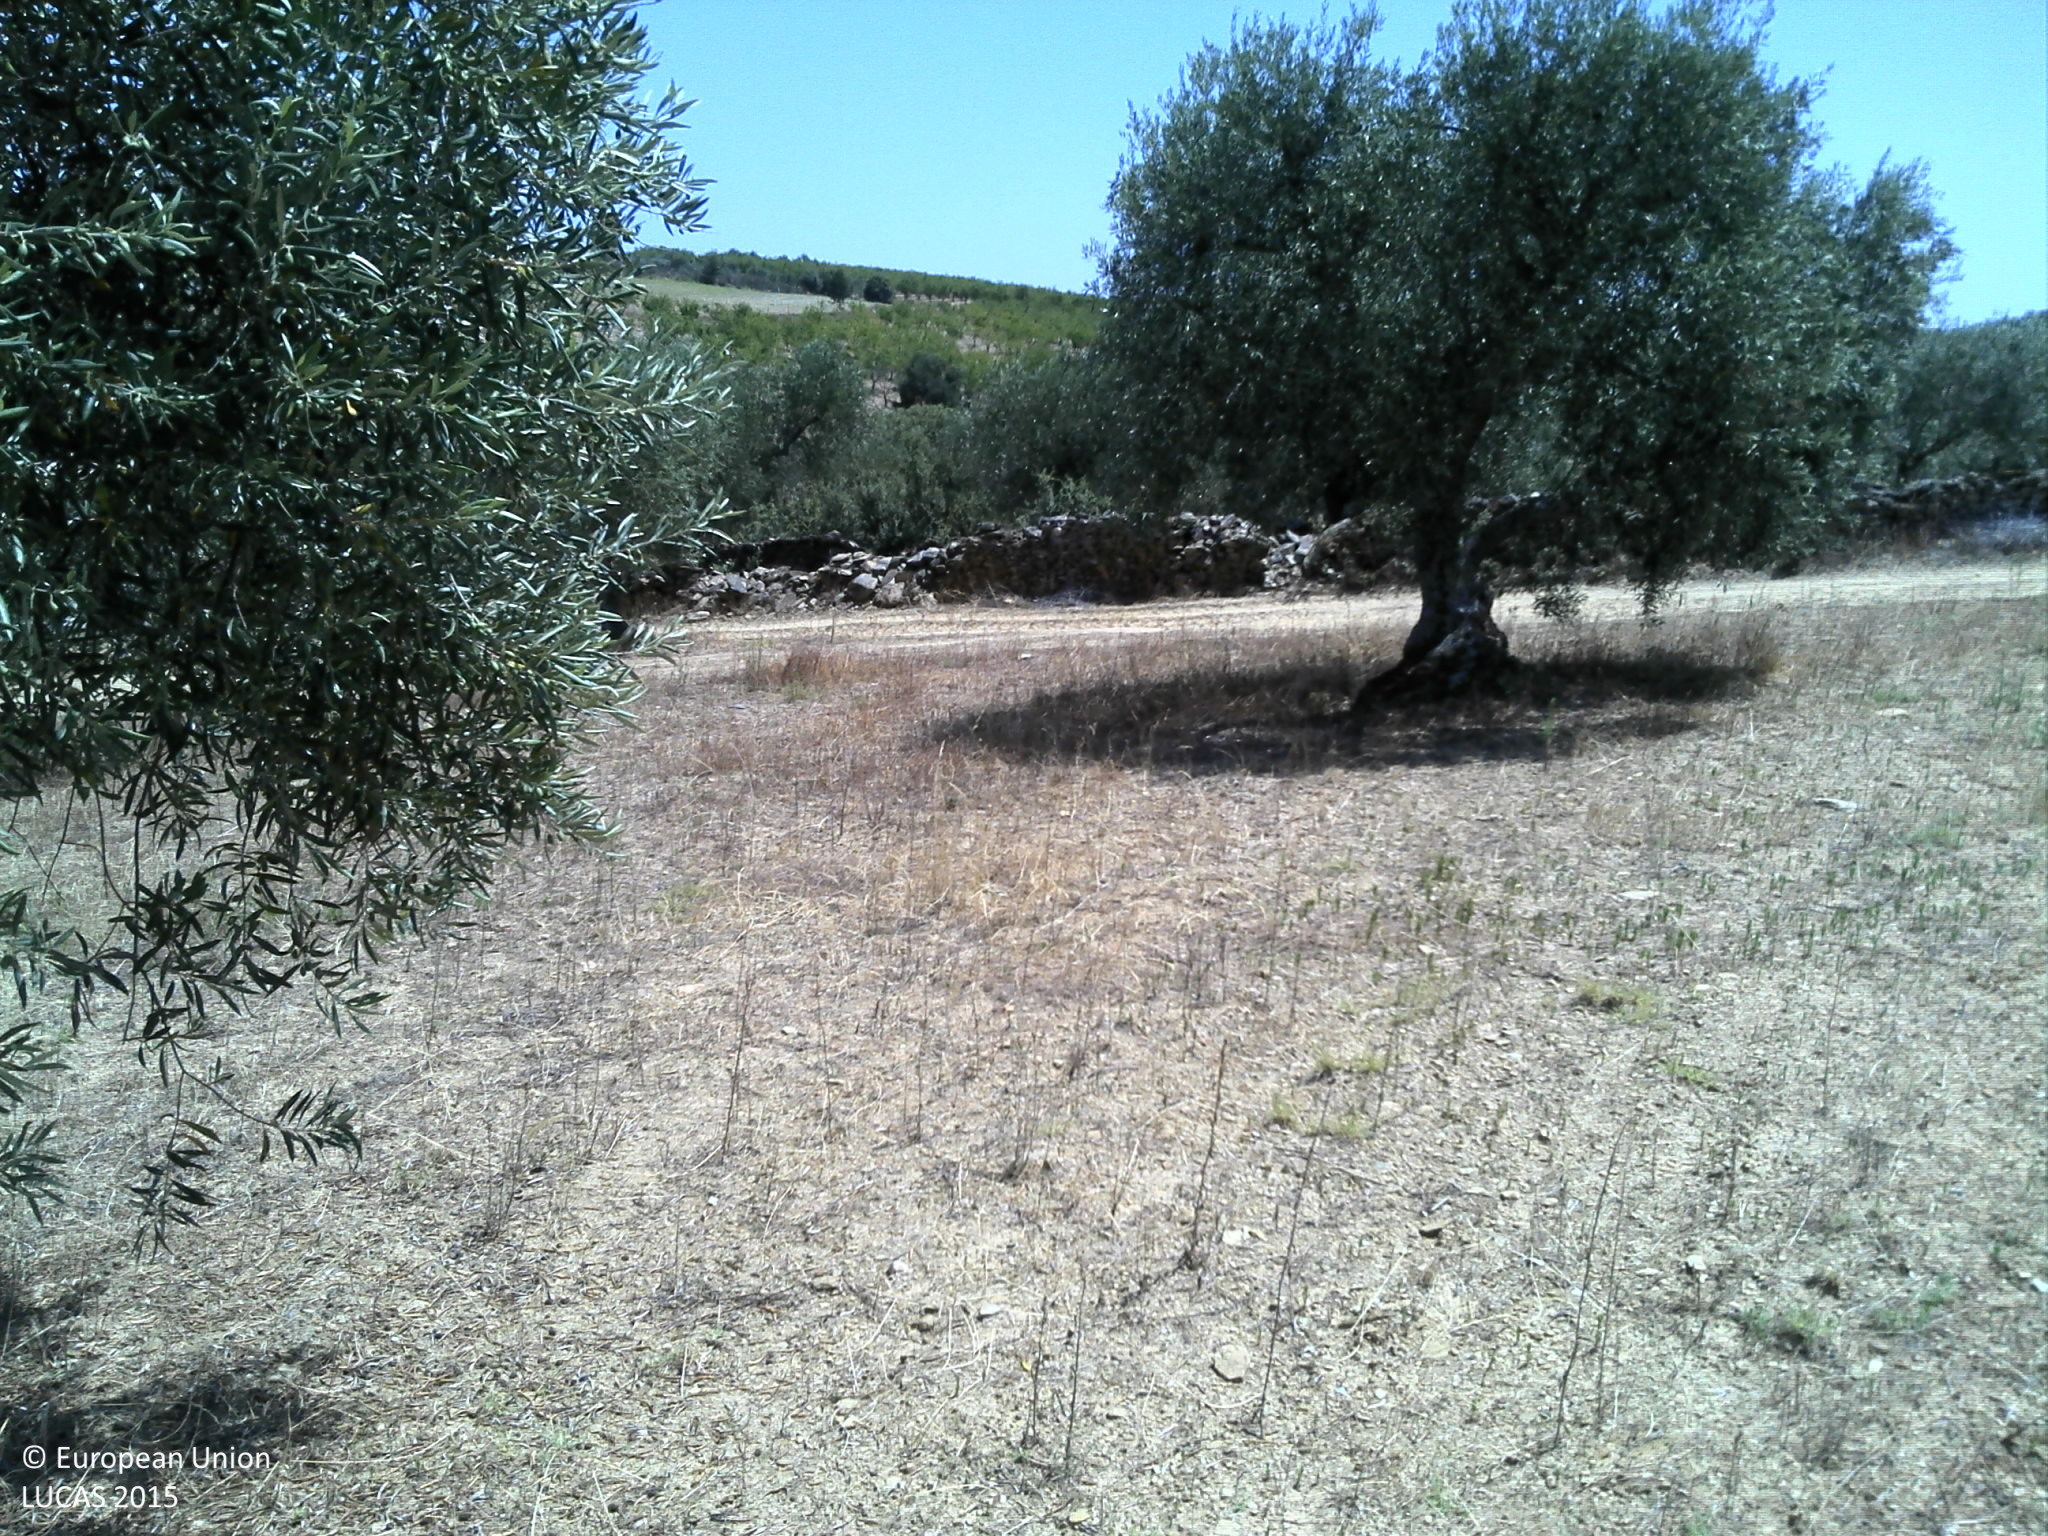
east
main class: Cropland
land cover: Olive groves
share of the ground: 25 - 50 %
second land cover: Grassland without tree/shrub cover
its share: < 10 %
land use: Agriculture (excluding fallow land and kitchen gardens)
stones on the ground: 10 - 25 %
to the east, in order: Olive groves; Grassland without tree/shrub cover; Olive groves; Tracks; Dry stone walls; Grass margins; Dry stone walls; Olive groves; Dry stone walls; Shruby margins; Fences; Apple fruit; Maize; Apple fruit; Maize; Fences; Apple fruit; Maize; Apple fruit; Fences; Dry stone walls; Ditches and canals; Dry stone walls; Nuts trees; Fences; Grassland with sparse tree/shrub cover; Fences; Nuts trees
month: July
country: PT
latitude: 41.0902
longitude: -7.4406
